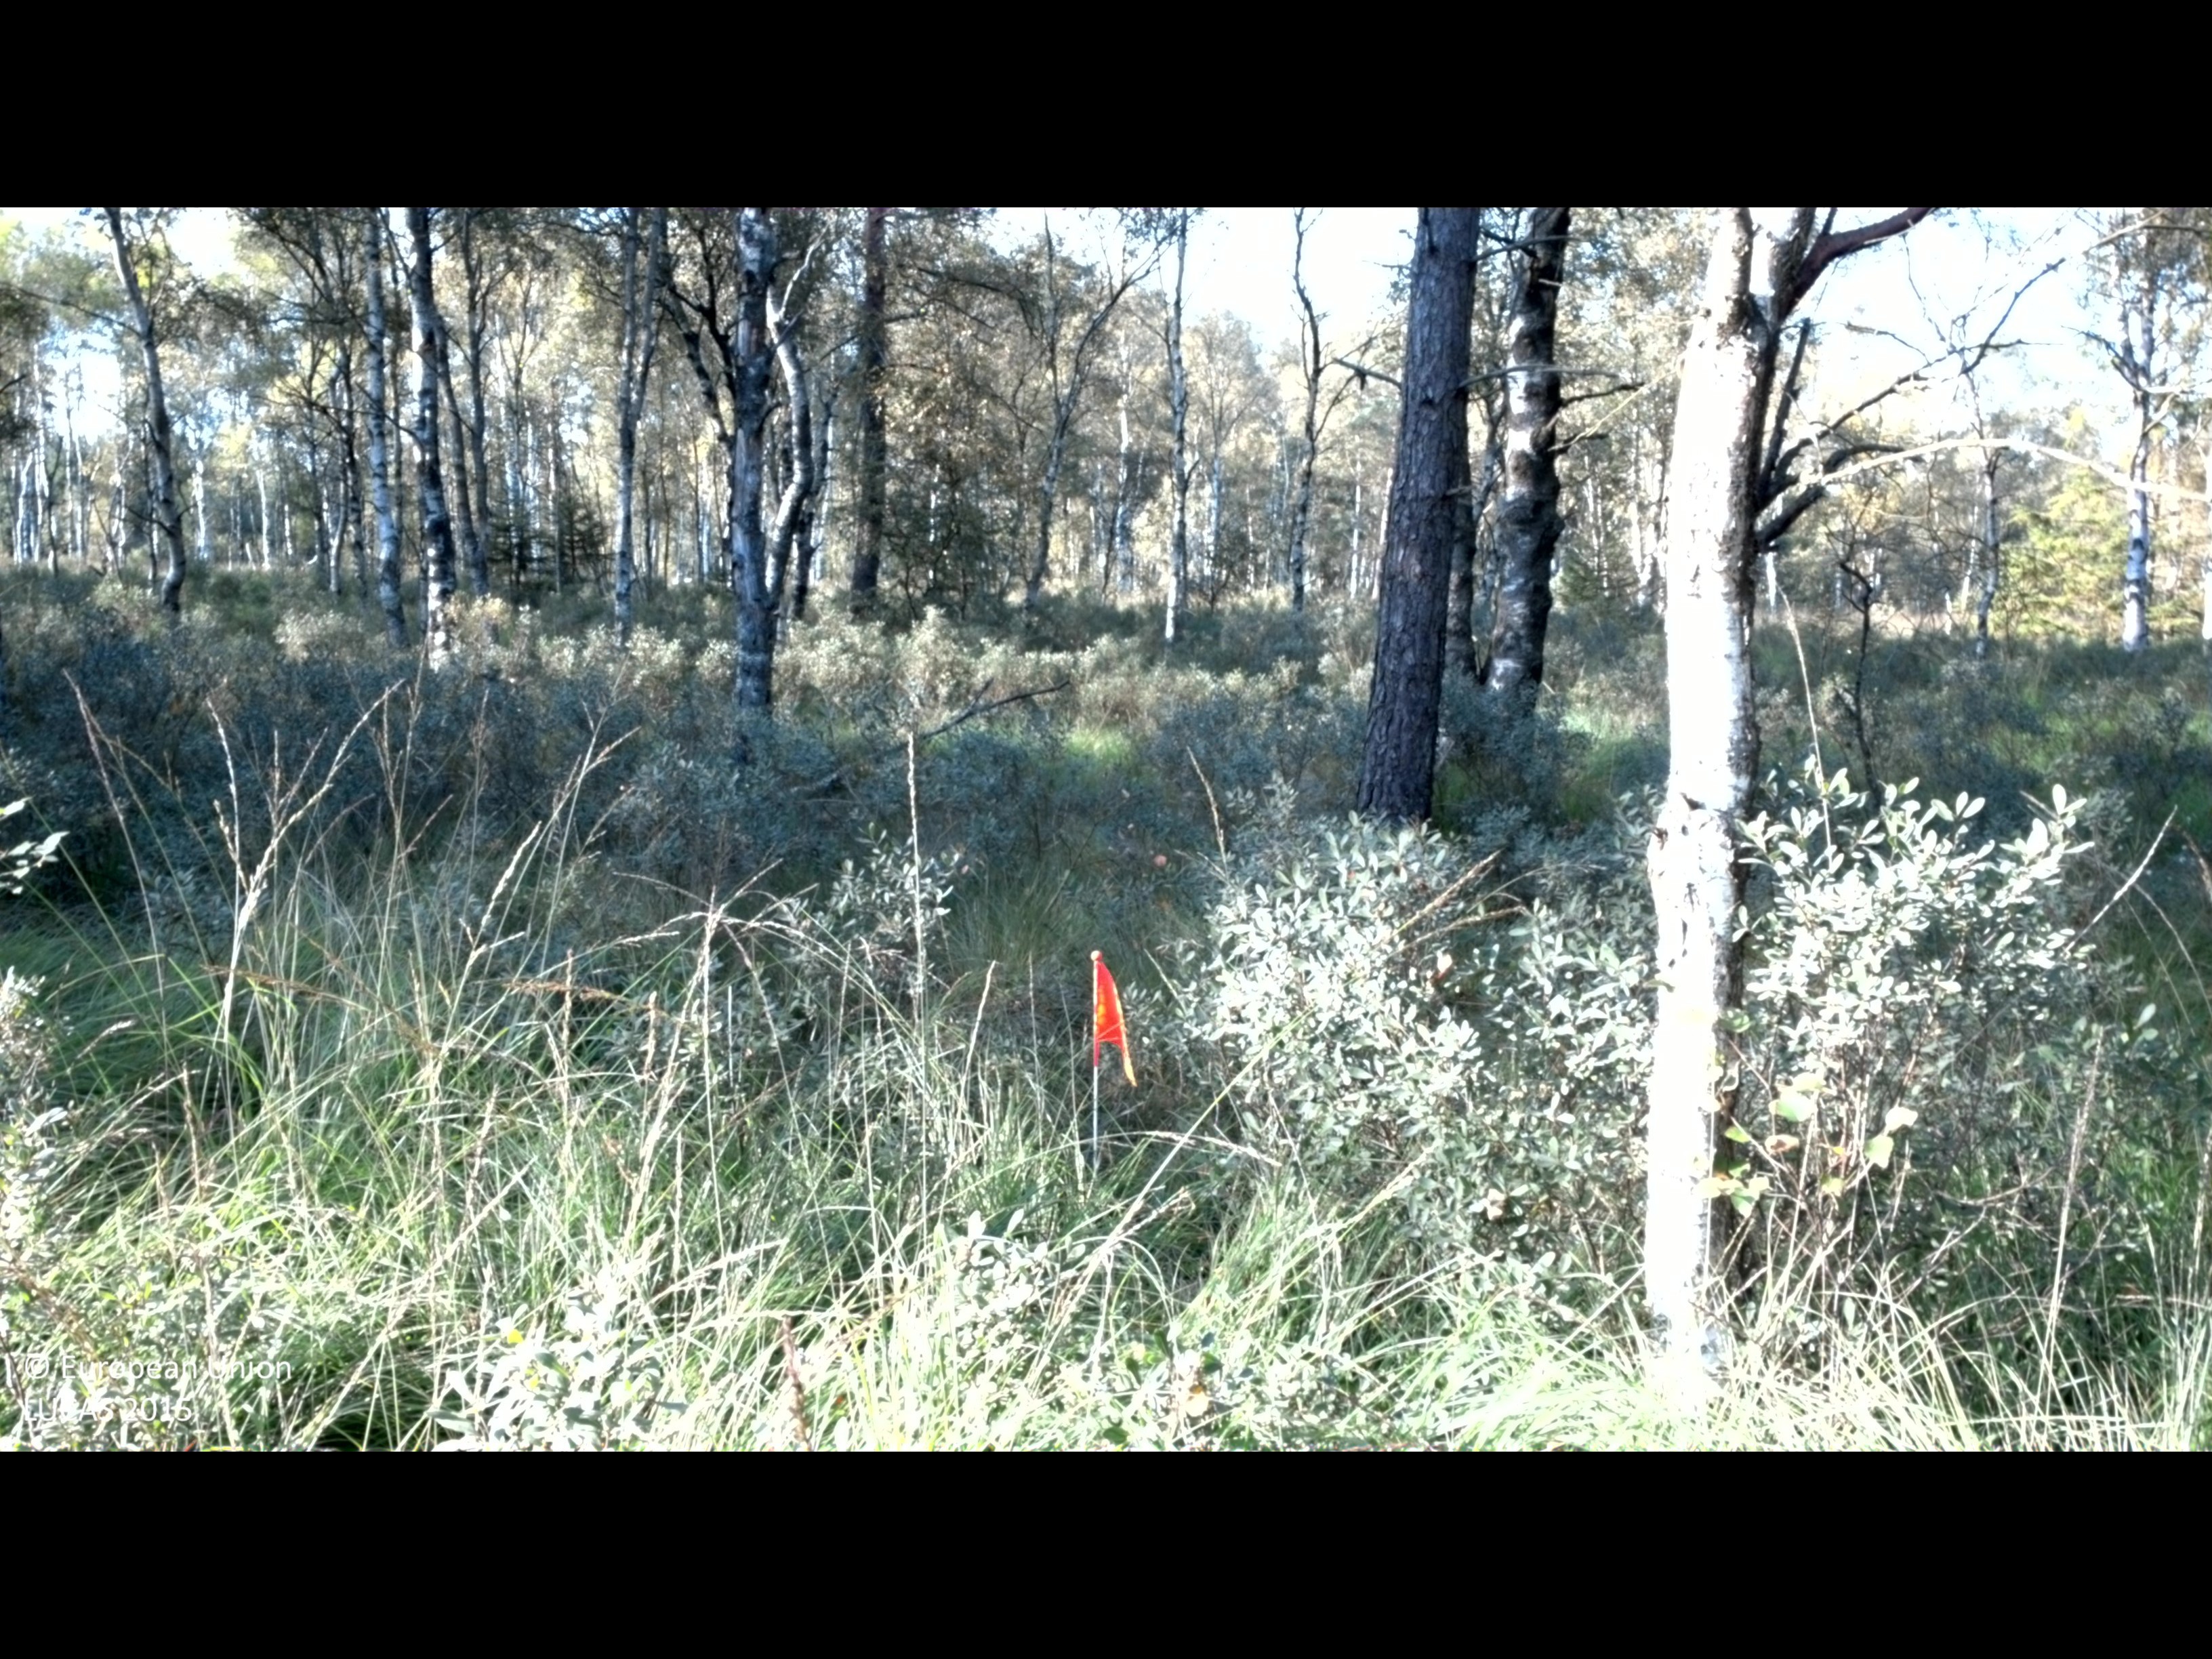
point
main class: Woodland
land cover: Pine dominated mixed woodland
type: boreal forest
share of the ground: 50 - 75 %
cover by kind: broadleaved forest trees 40 %, shrubs 25 %, herbaceous plants 20 %, coniferous forest trees 15 %
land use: Semi-natural and natural areas not in use
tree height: > 5 m
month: August
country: SE
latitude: 56.7233
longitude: 13.2160
